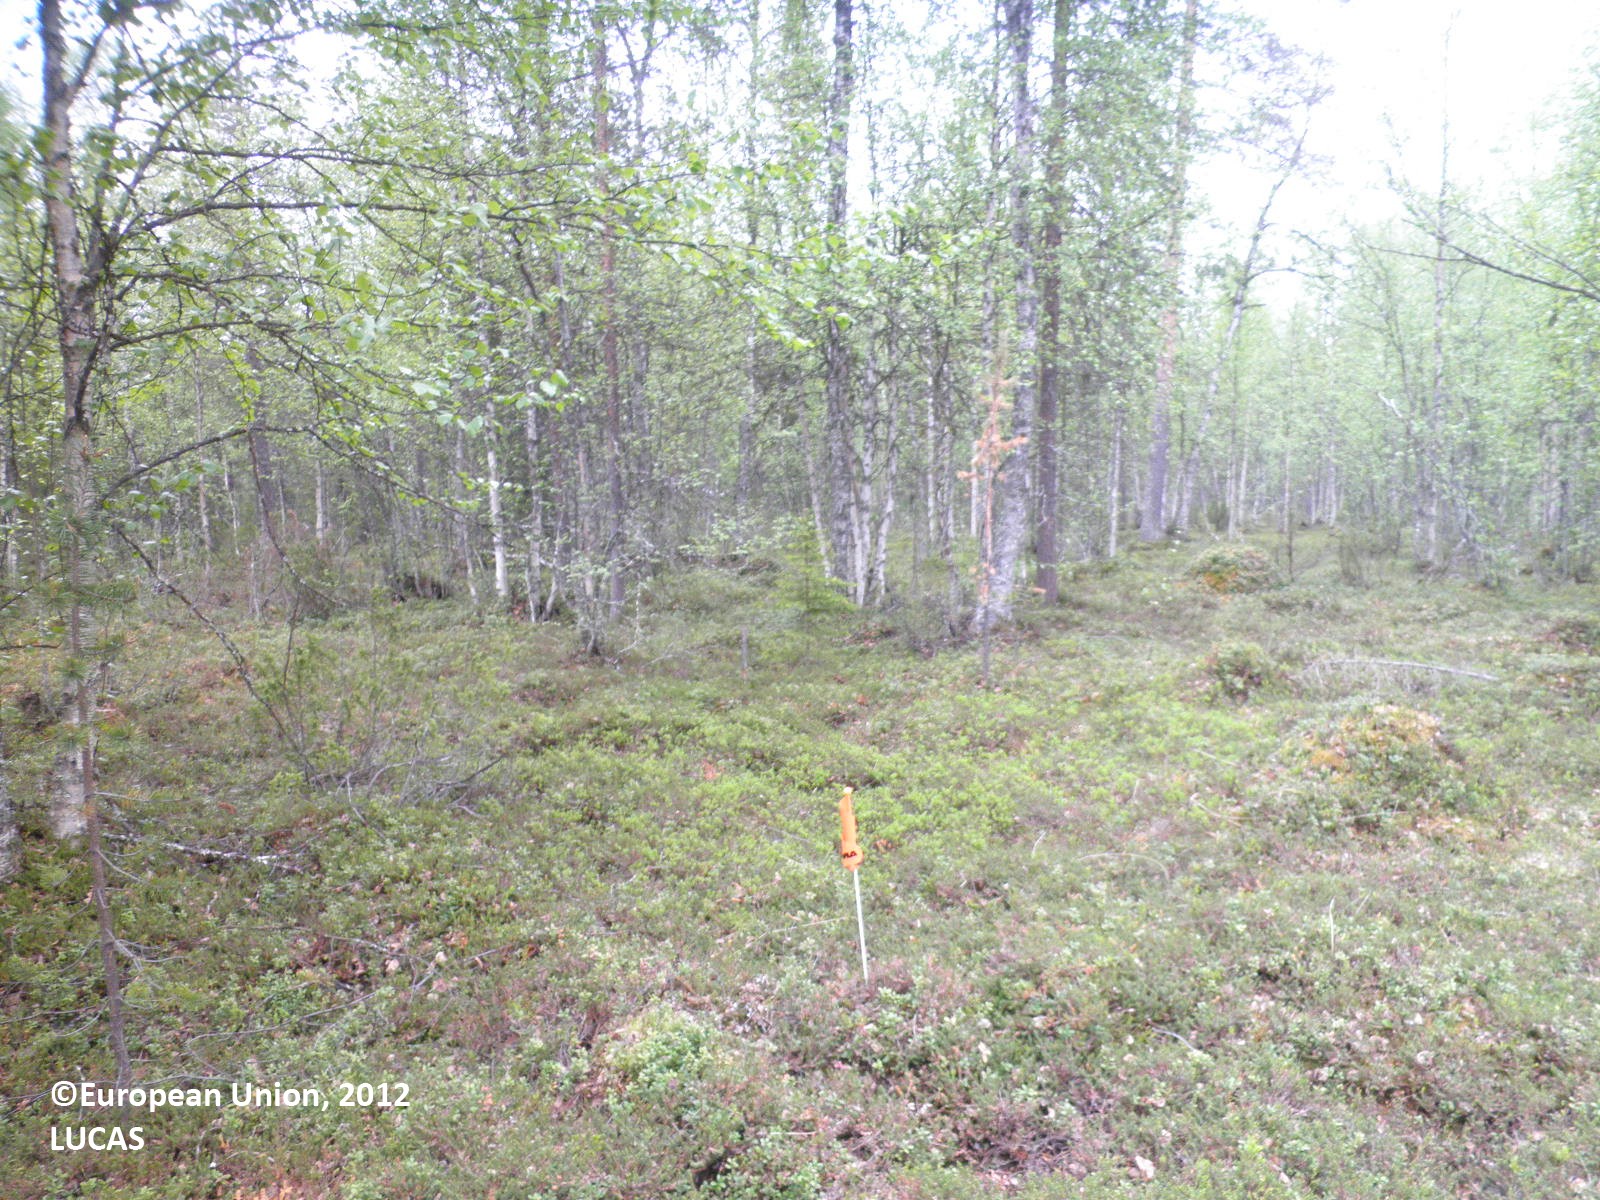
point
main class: Woodland
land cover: Pine dominated mixed woodland
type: boreal forest
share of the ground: 25 - 50 %
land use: Forestry
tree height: > 5 m
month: June
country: FI
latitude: 67.9312
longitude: 25.4728
